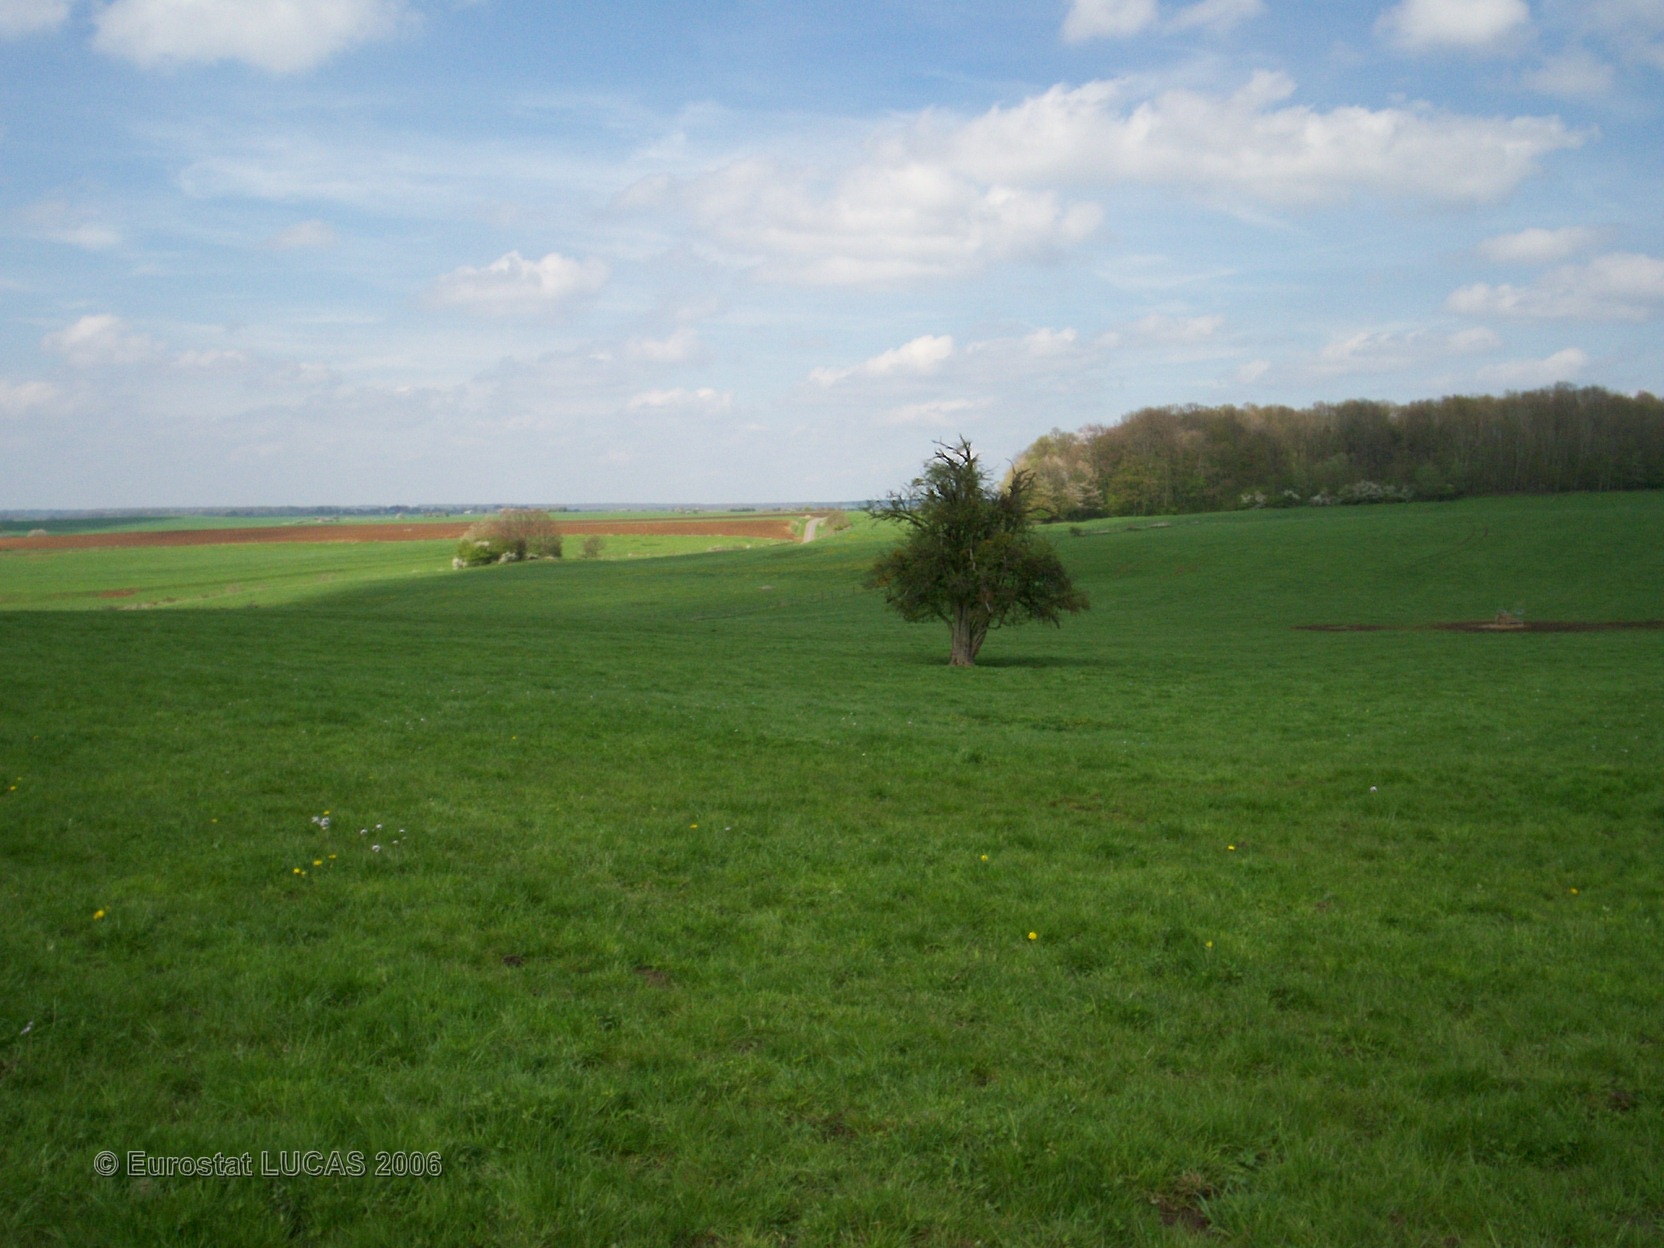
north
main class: Grassland
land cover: Grassland without tree/shrub cover
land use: Agriculture (excluding fallow land and kitchen gardens)
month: May
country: FR
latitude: 49.8286
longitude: 4.3655
